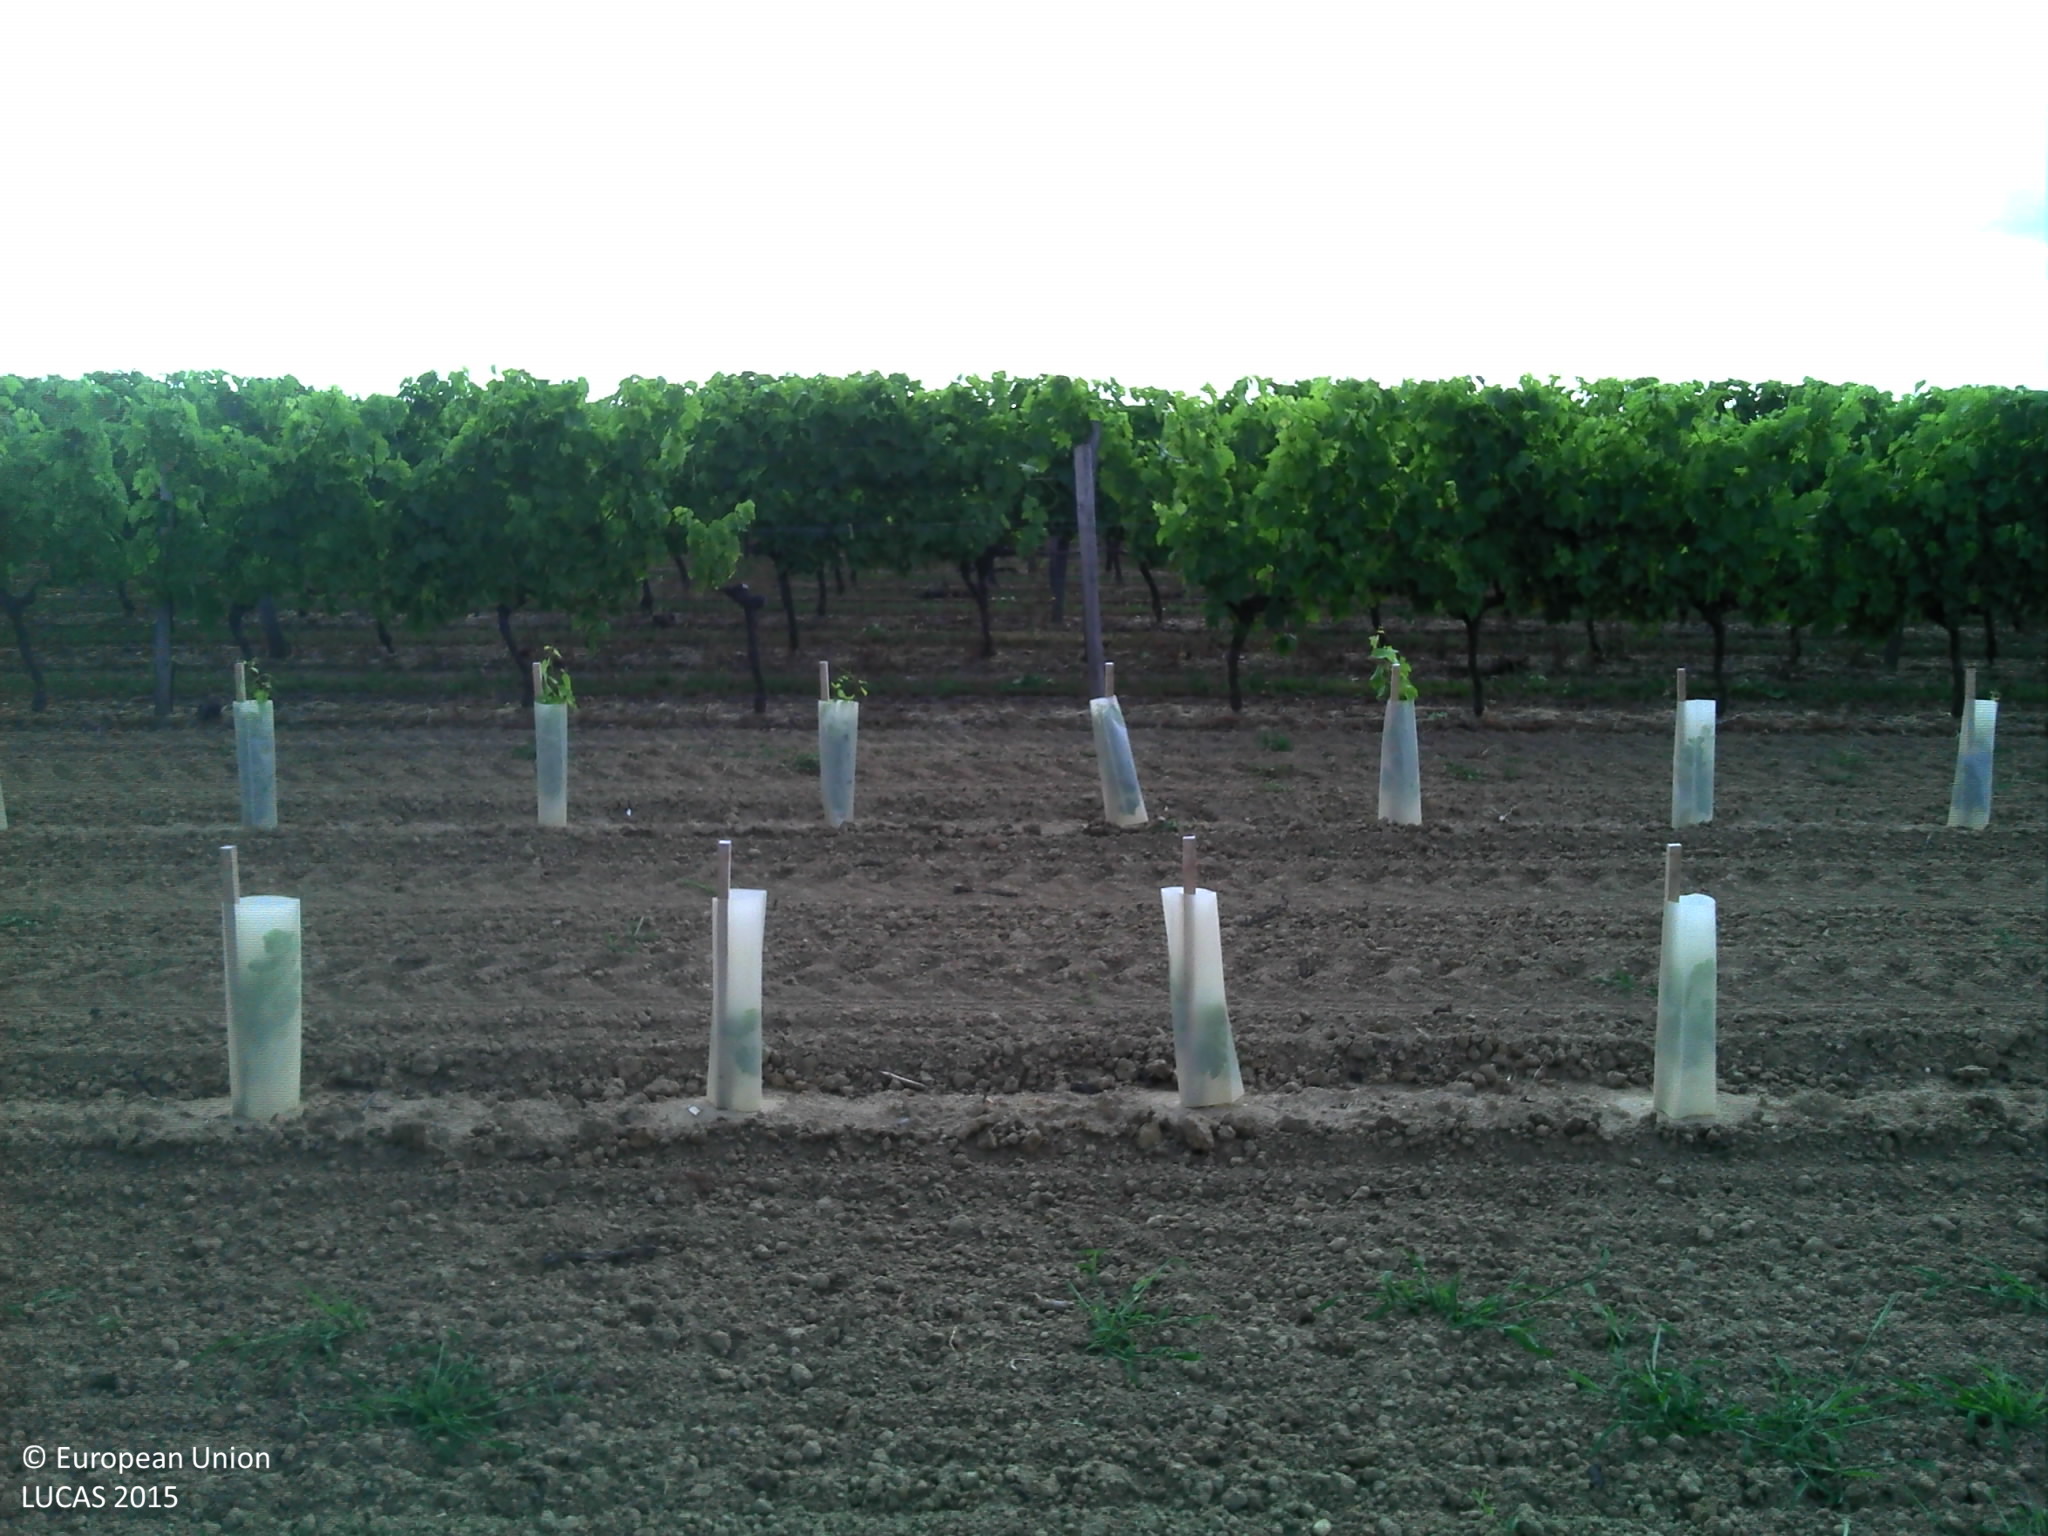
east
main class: Cropland
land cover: Vineyards
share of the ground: > 75 %
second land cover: Other bare soil
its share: > 75 %
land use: Agriculture (excluding fallow land and kitchen gardens)
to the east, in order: Vineyards; Other bare soil; Grassland without tree/shrub cover; Tracks; Grass margins; Paved roads, cycling and walking lanes; Grass margins; Paved roads, cycling and walking lanes
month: July
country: FR
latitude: 45.3021
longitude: -0.5421
